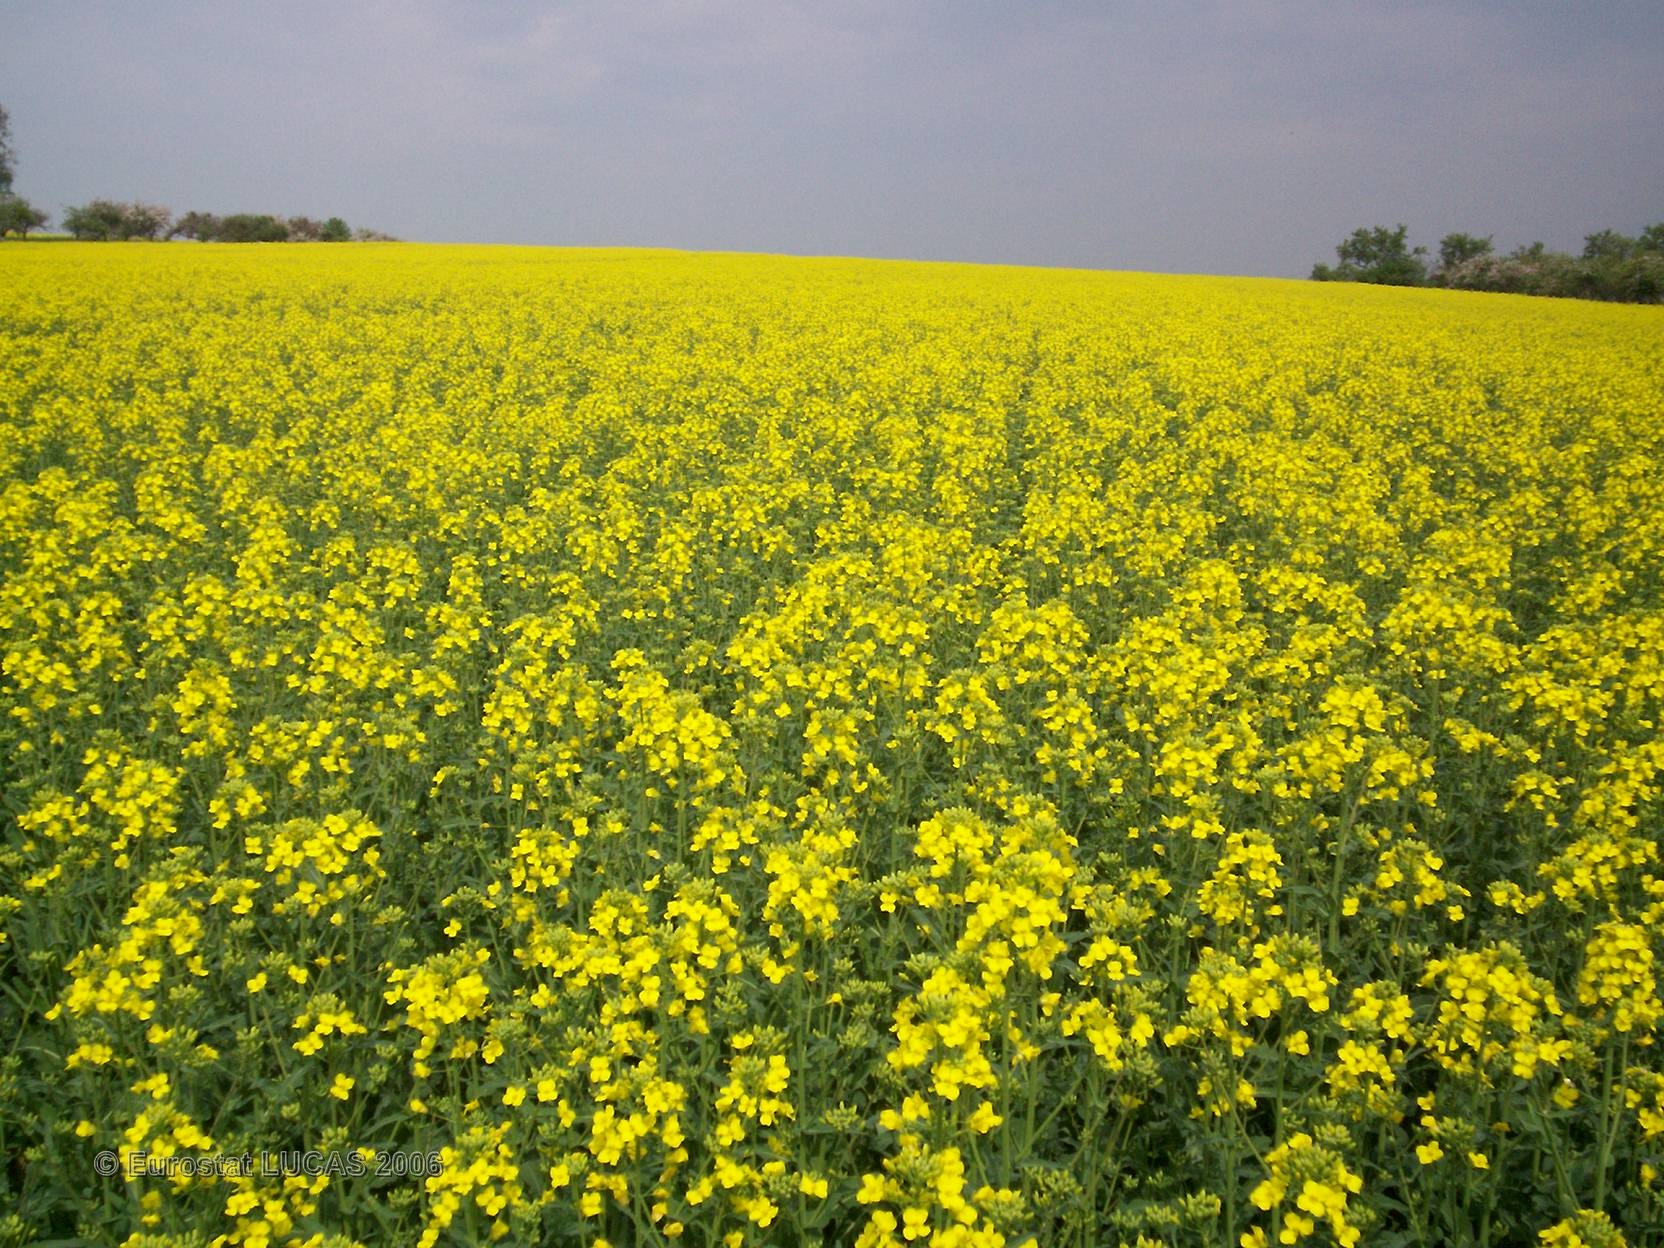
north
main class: Cropland
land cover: Rape and turnip rape
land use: Agriculture (excluding fallow land and kitchen gardens)
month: May
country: FR
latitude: 49.2278
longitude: 6.4159
